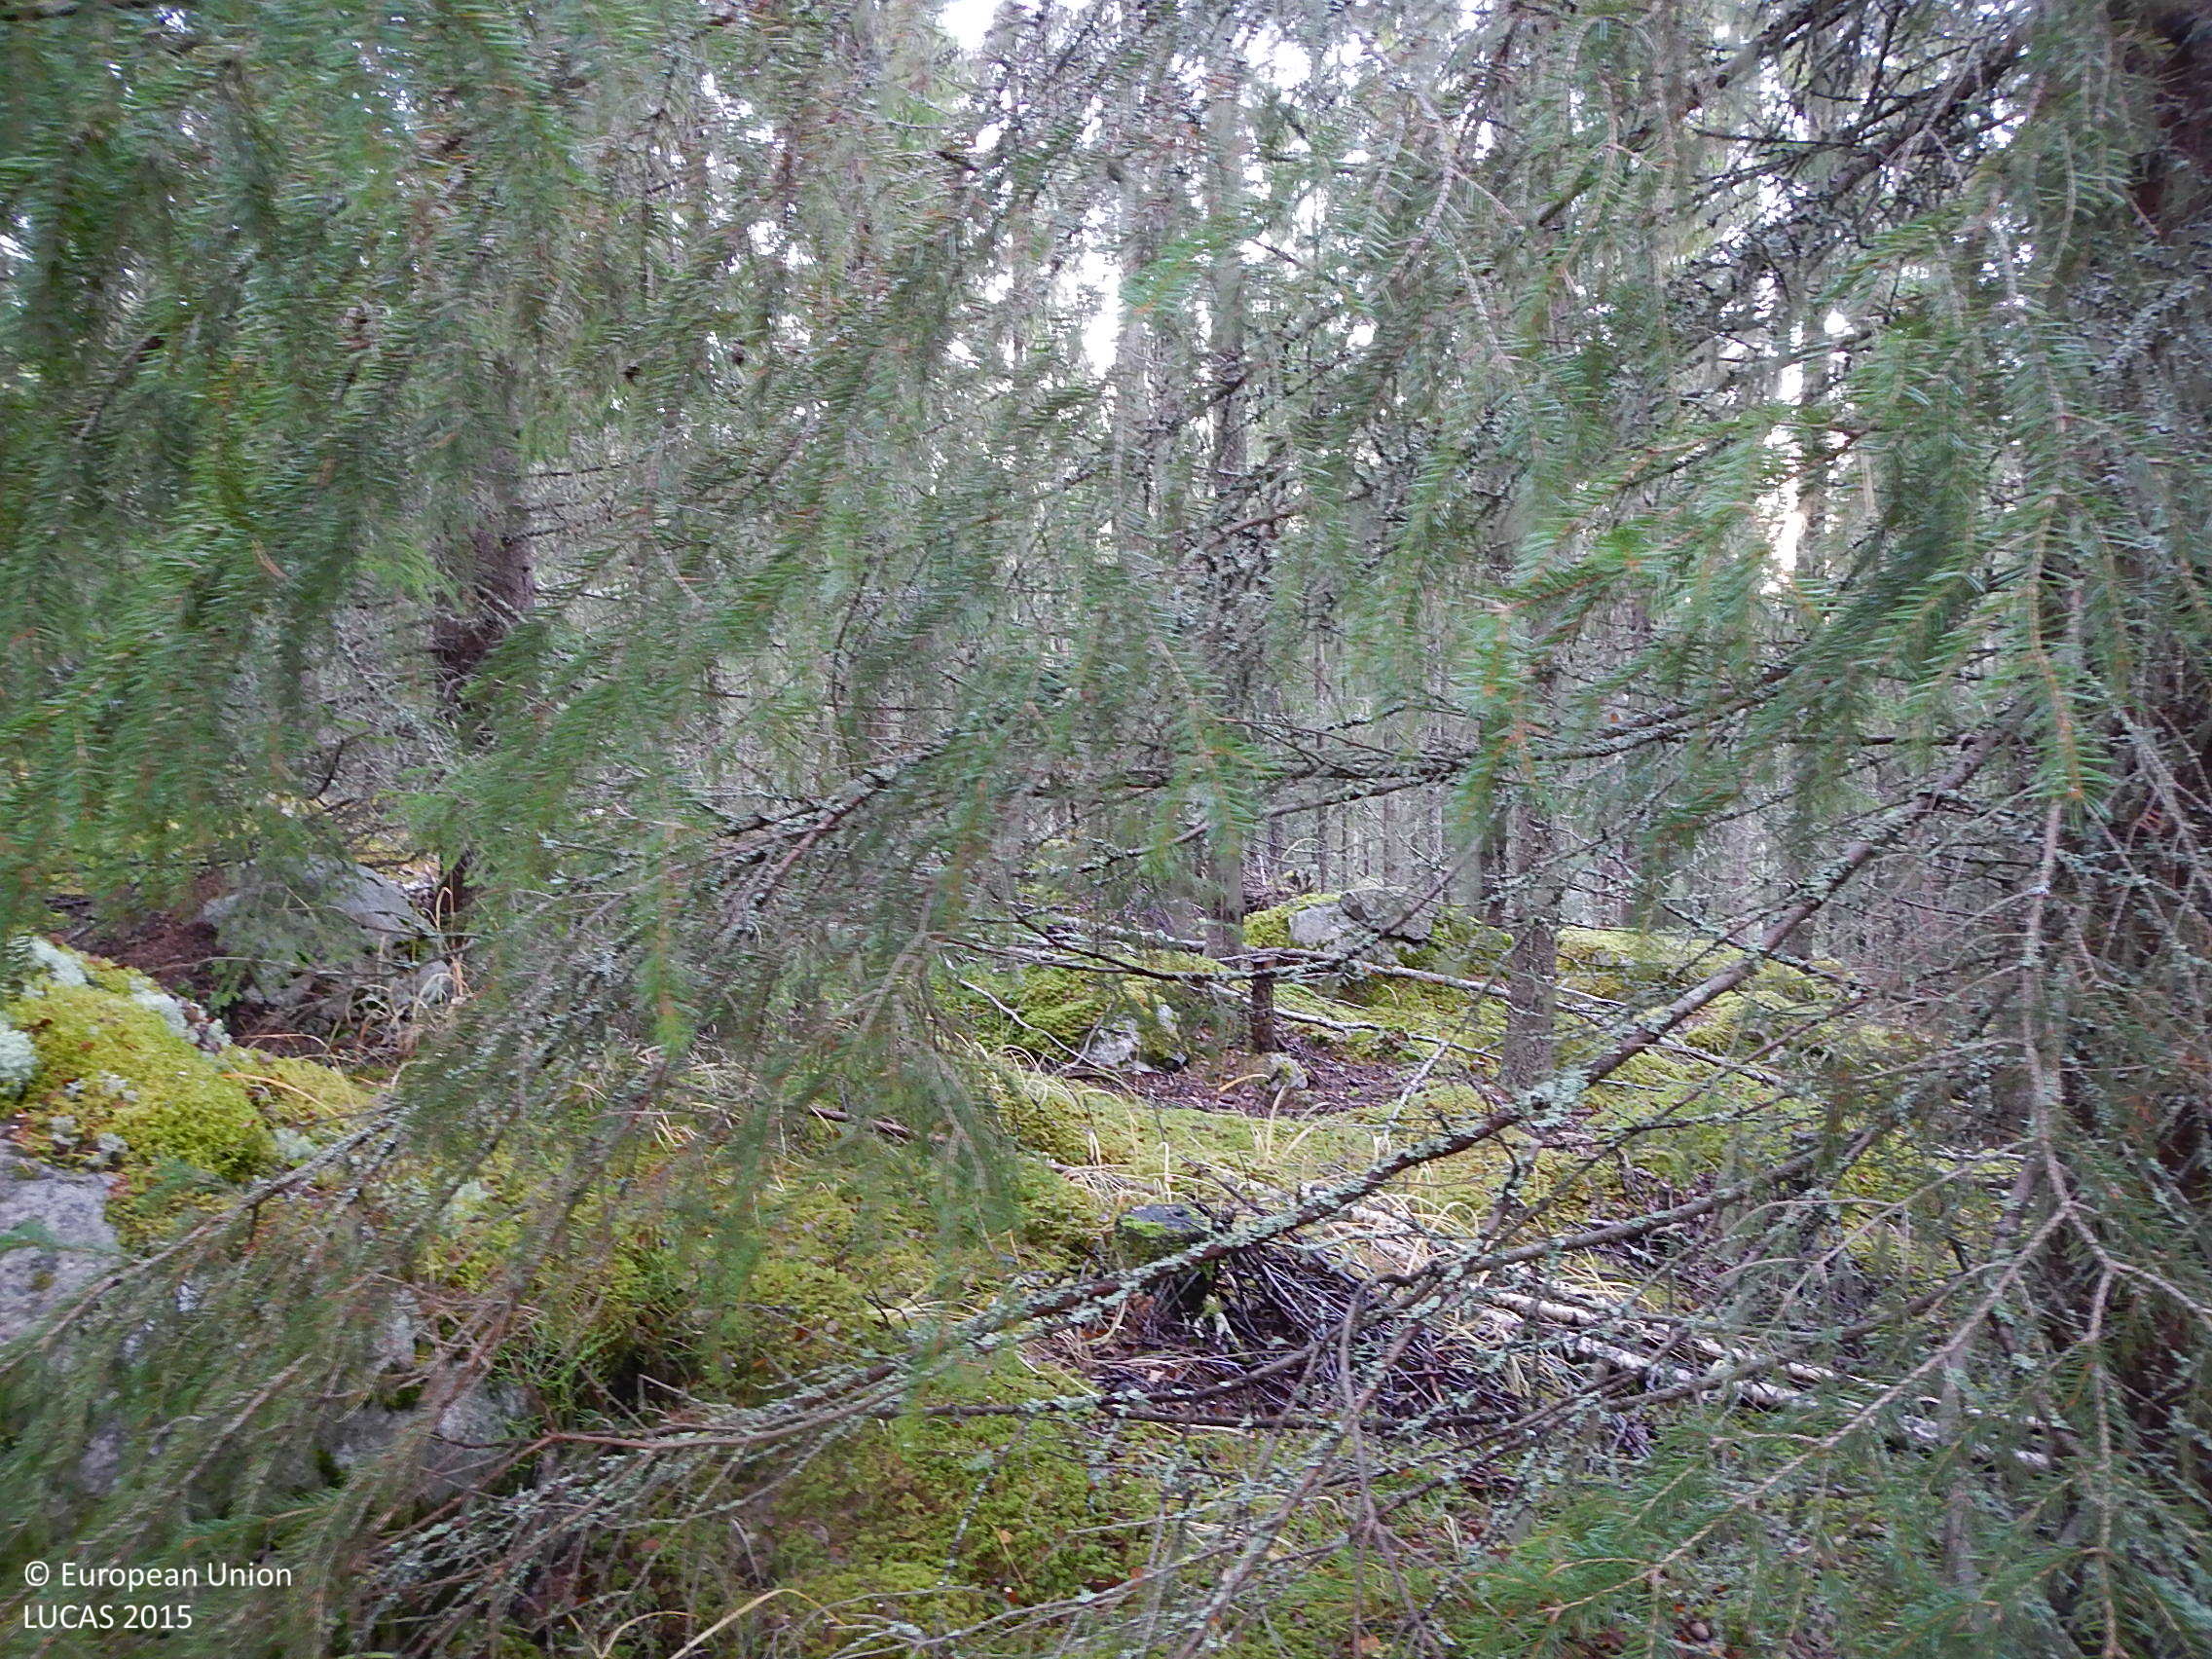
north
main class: Woodland
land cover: Spruce dominated coniferous woodland
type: boreal forest
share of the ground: > 75 %
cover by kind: coniferous forest trees 70 %, lichens and mosses 20 %, broadleaved forest trees 5 %, herbaceous plants 5 %
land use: Forestry
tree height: > 5 m
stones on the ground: < 10 %
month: November
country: SE
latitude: 61.2692
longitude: 15.8592
